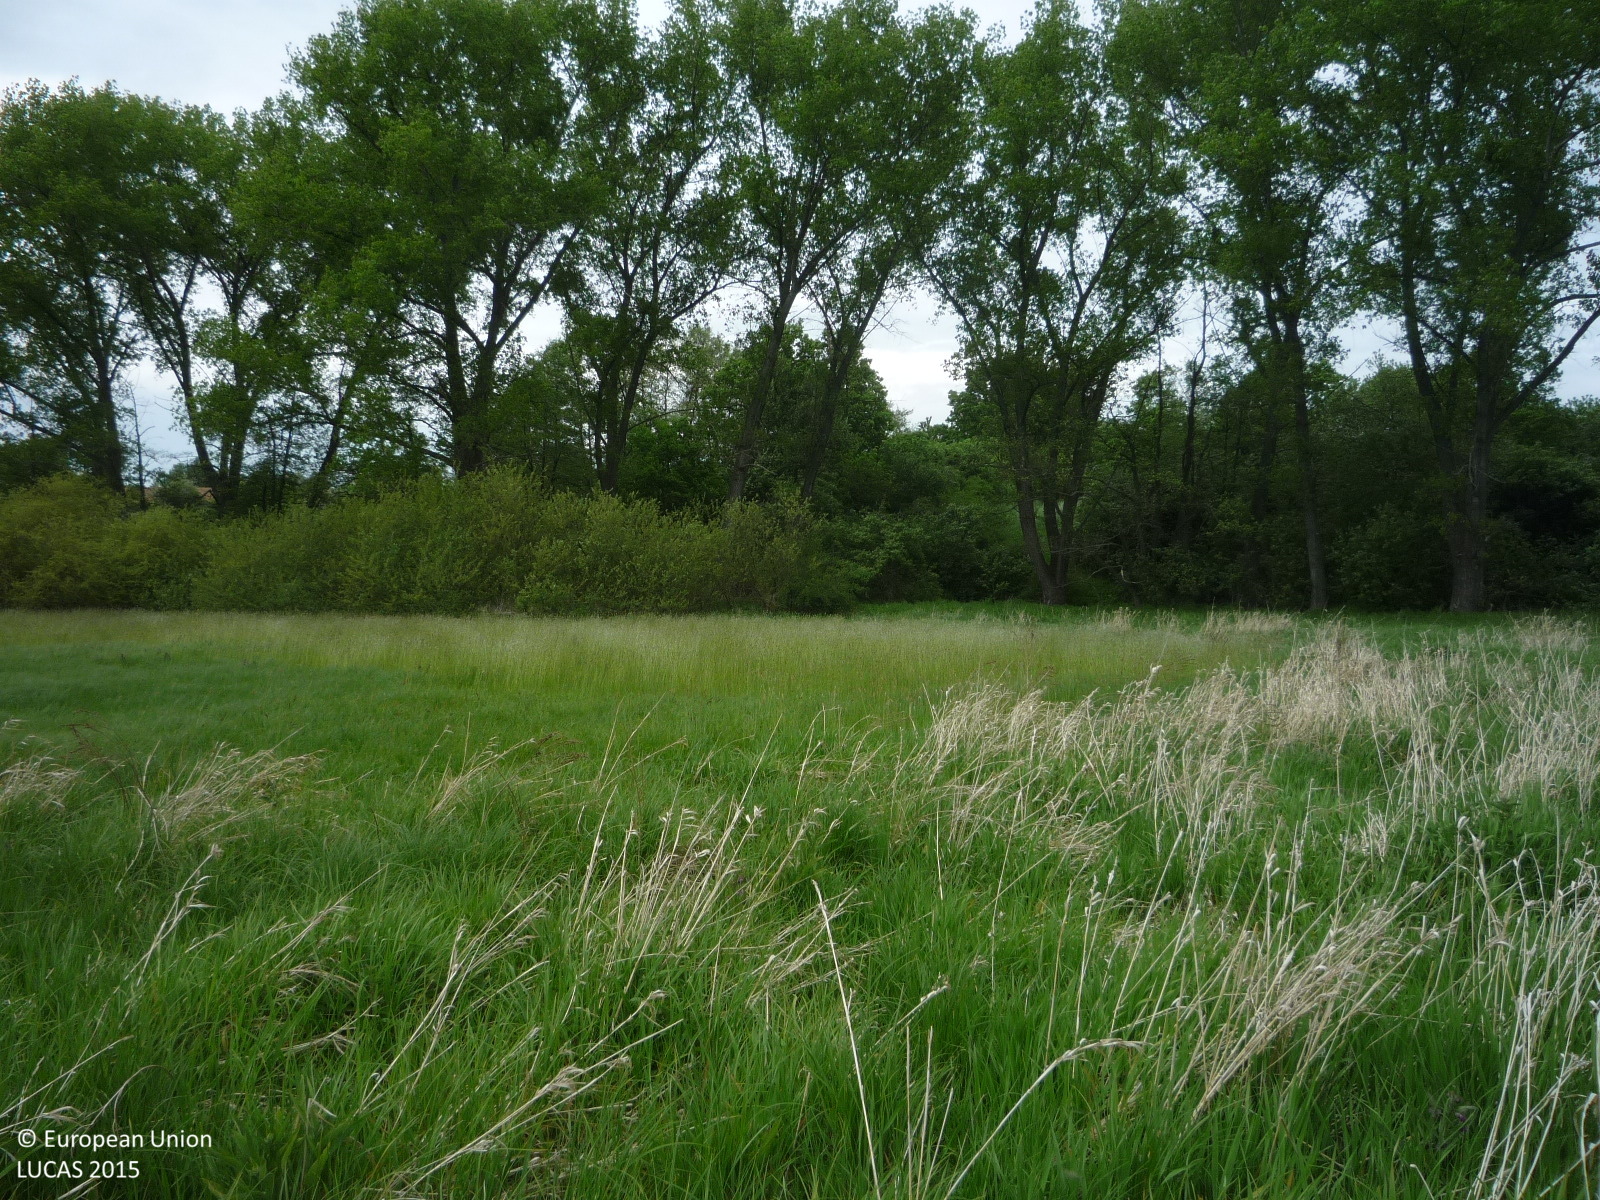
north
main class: Grassland
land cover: Grassland without tree/shrub cover
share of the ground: > 75 %
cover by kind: herbaceous plants 100 %
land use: Semi-natural and natural areas not in use
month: May
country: CZ
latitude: 50.0197
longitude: 14.5937
